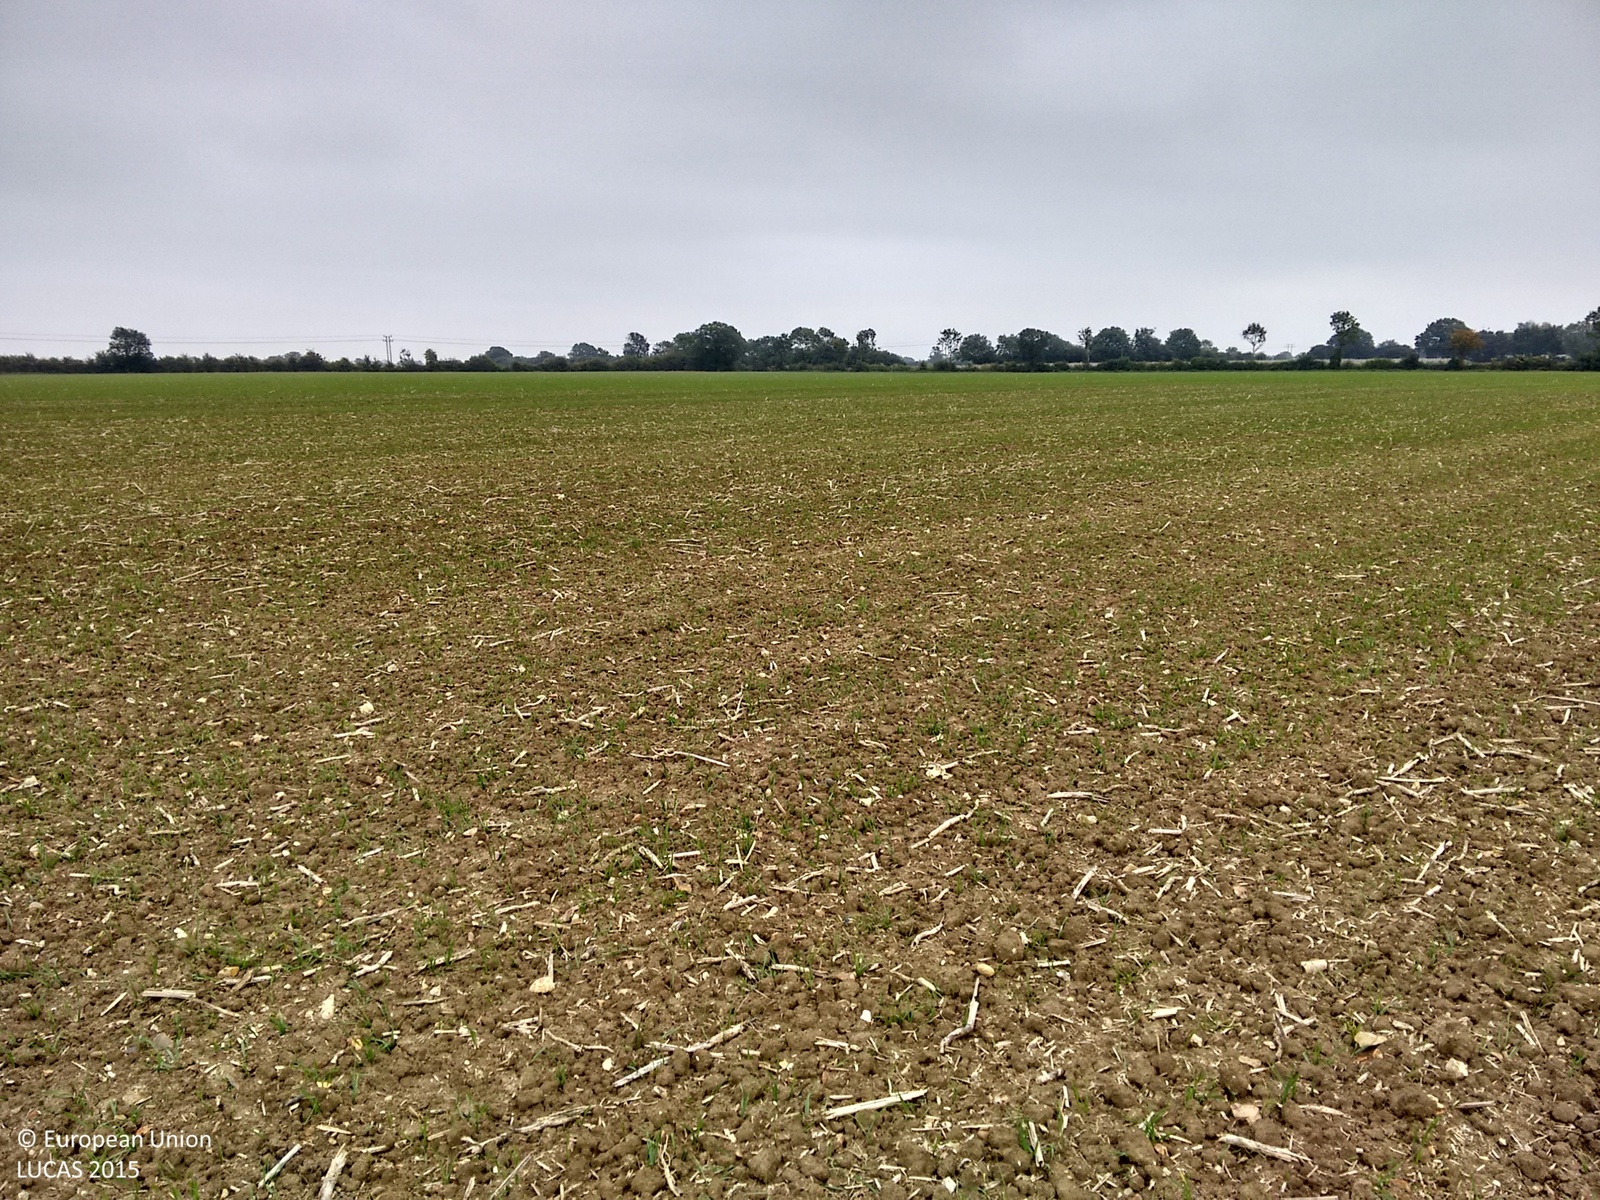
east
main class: Cropland
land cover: Common wheat
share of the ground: < 10 %
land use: Agriculture (excluding fallow land and kitchen gardens)
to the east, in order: Common wheat
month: October
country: GB
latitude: 52.3956
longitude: 1.4717
